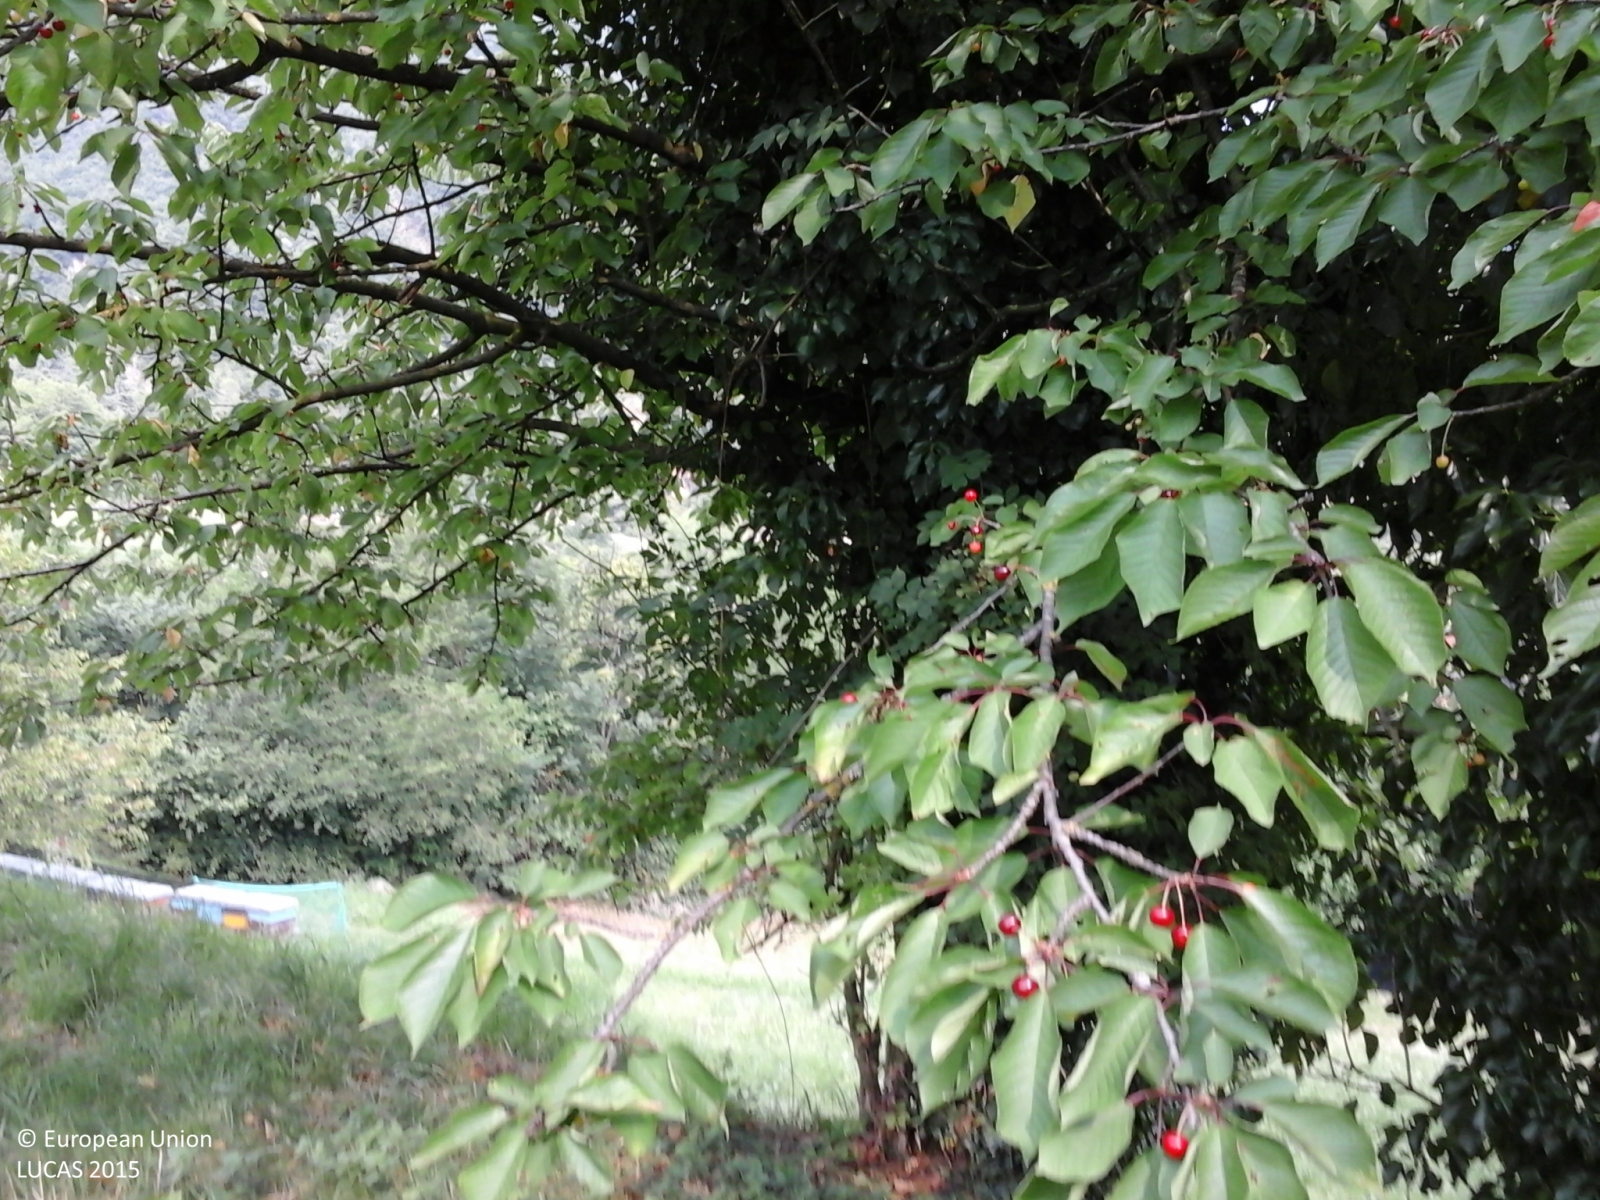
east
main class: Grassland
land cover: Grassland with sparse tree/shrub cover
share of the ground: > 75 %
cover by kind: herbaceous plants 95 %, broadleaved forest trees 5 %
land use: Agriculture (excluding fallow land and kitchen gardens)
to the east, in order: Grassland with sparse tree/shrub cover; Grassland without tree/shrub cover; Broadleaved woodland; Tracks; Electric lines; Broadleaved woodland; Rivers and streams; Broadleaved woodland; Artificial constructions in urban areas; Broadleaved woodland; Electric lines; Broadleaved woodland; Electric lines; Broadleaved woodland; Artificial constructions in urban areas; Shrubland with sparse tree cover; Abandoned hedges; Inland fresh running water; Abandoned hedges; Paved roads, cycling and walking lanes; Grassland with sparse tree/shrub cover; Paved roads, cycling and walking lanes
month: June
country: IT
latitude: 45.6664
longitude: 10.2178
